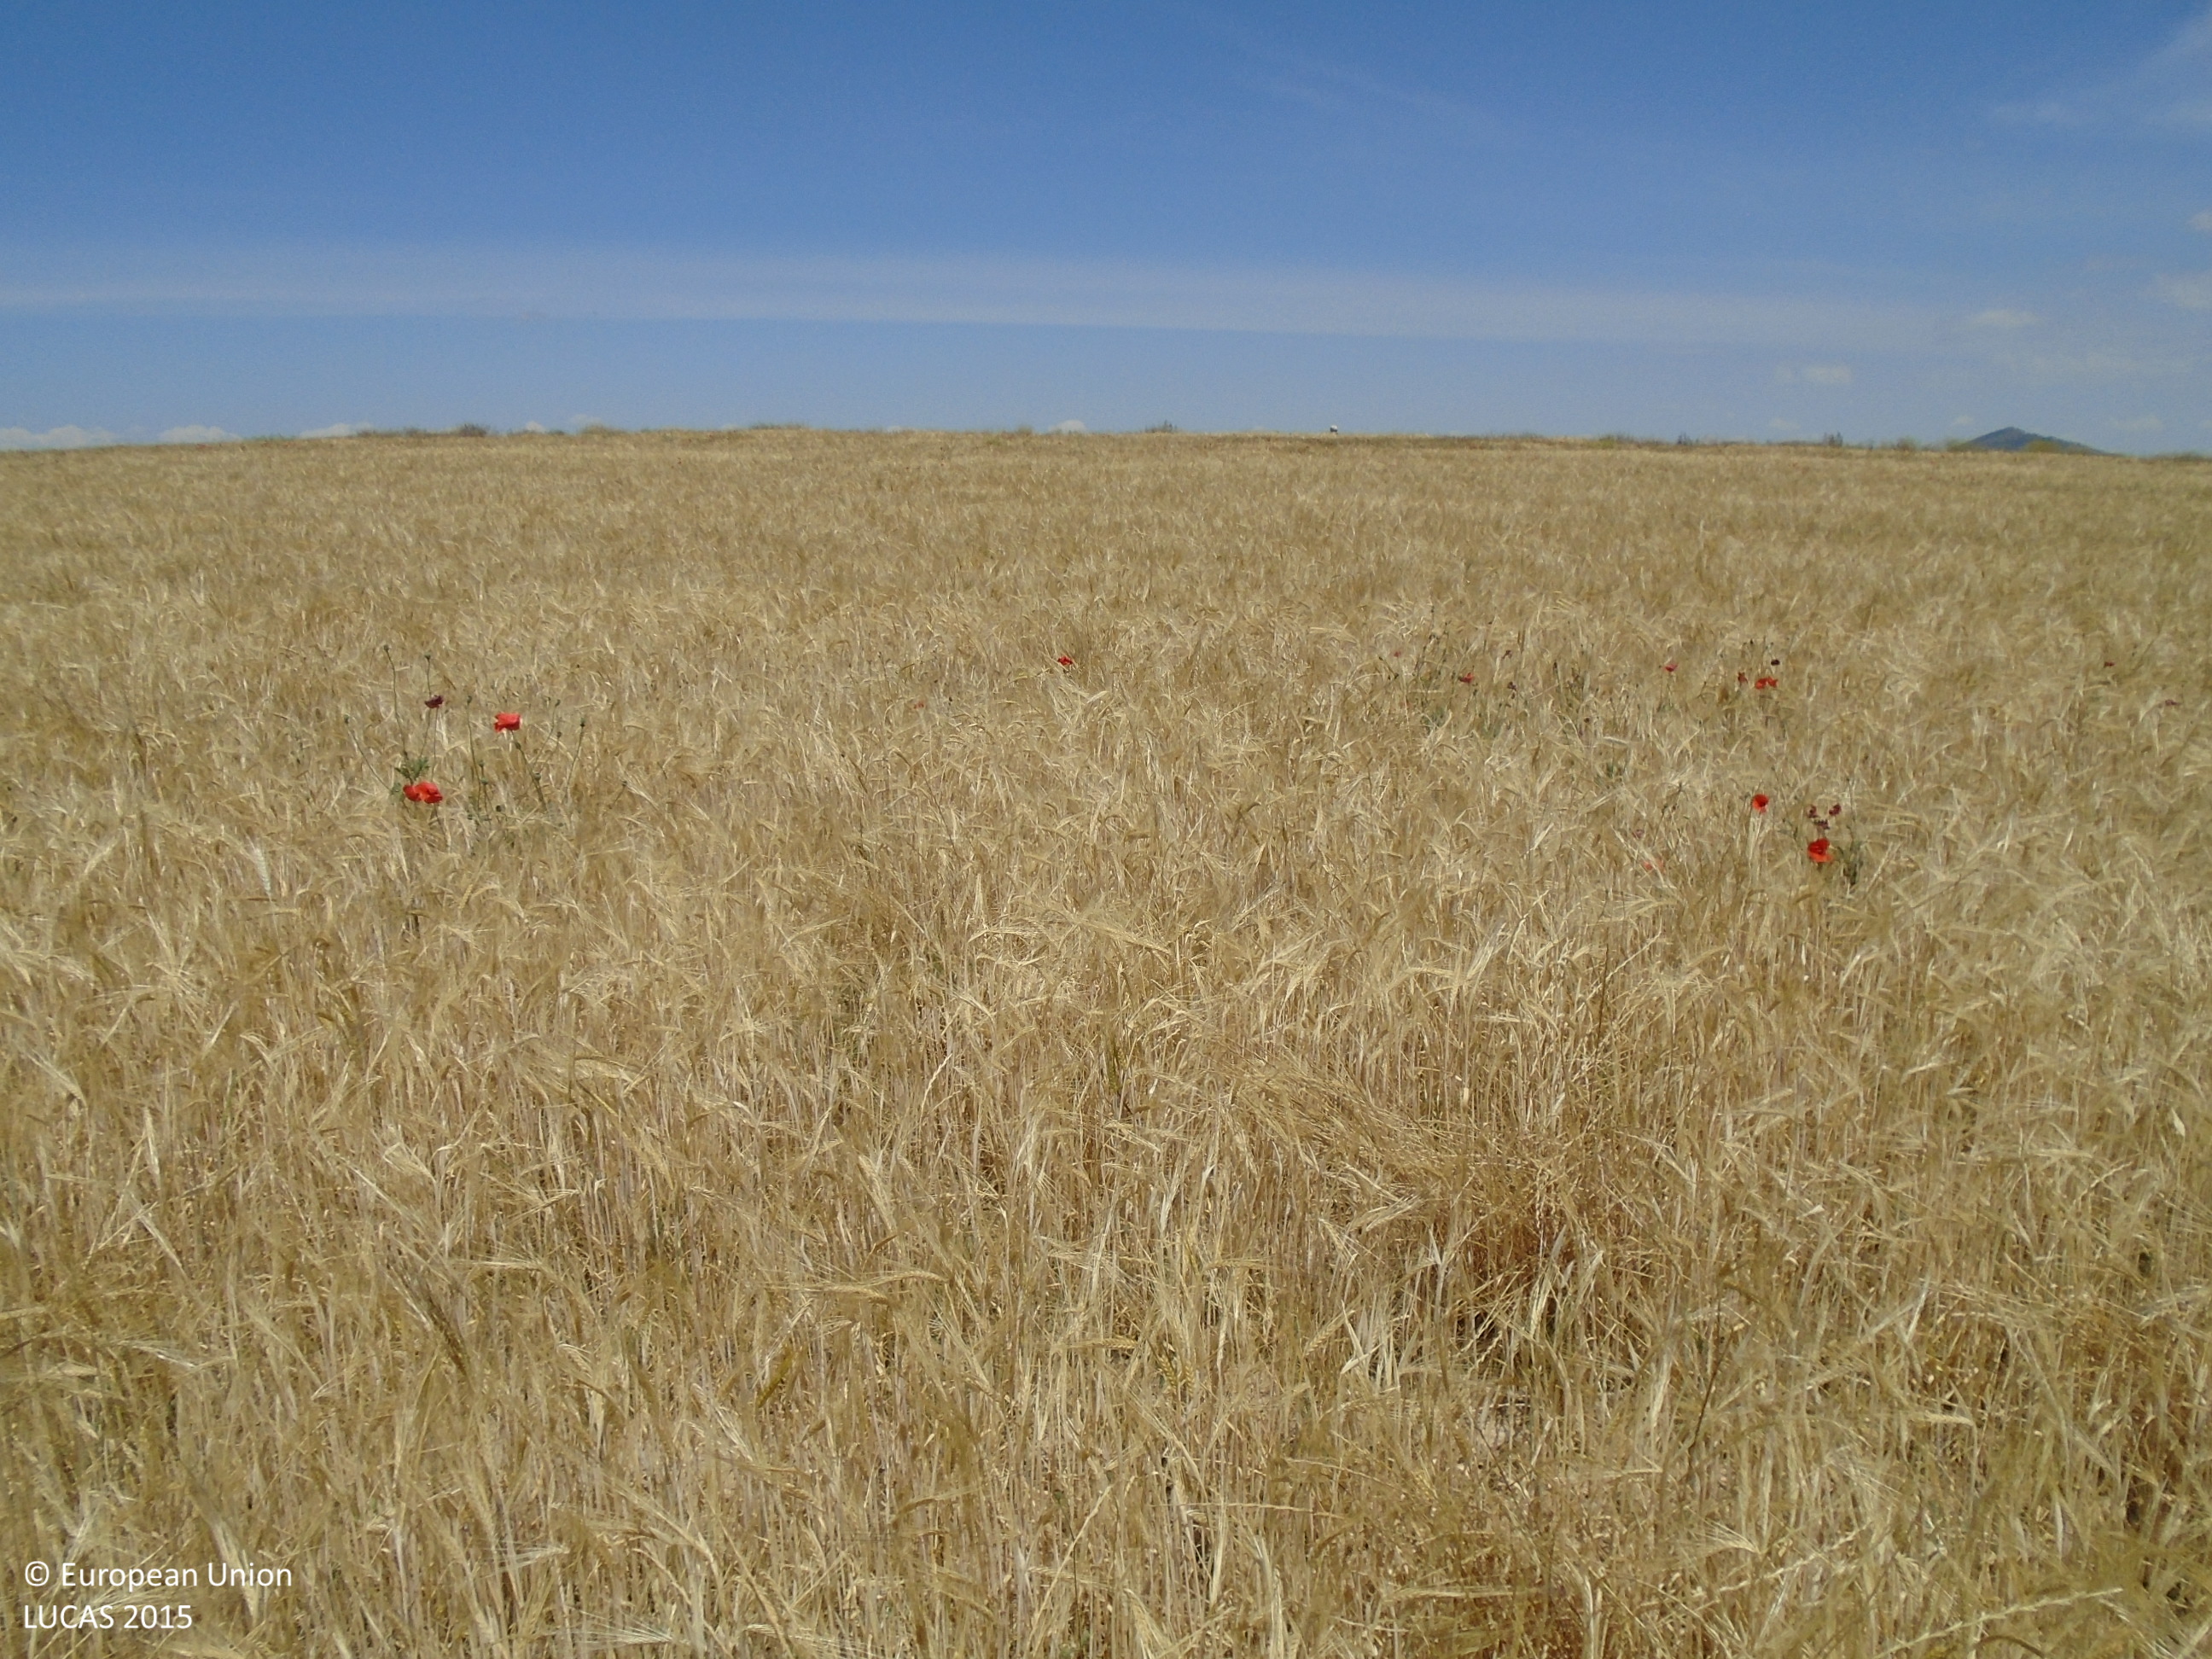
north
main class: Cropland
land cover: Barley
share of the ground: > 75 %
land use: Agriculture (excluding fallow land and kitchen gardens)
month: May
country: ES
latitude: 39.6802
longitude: -4.2473
